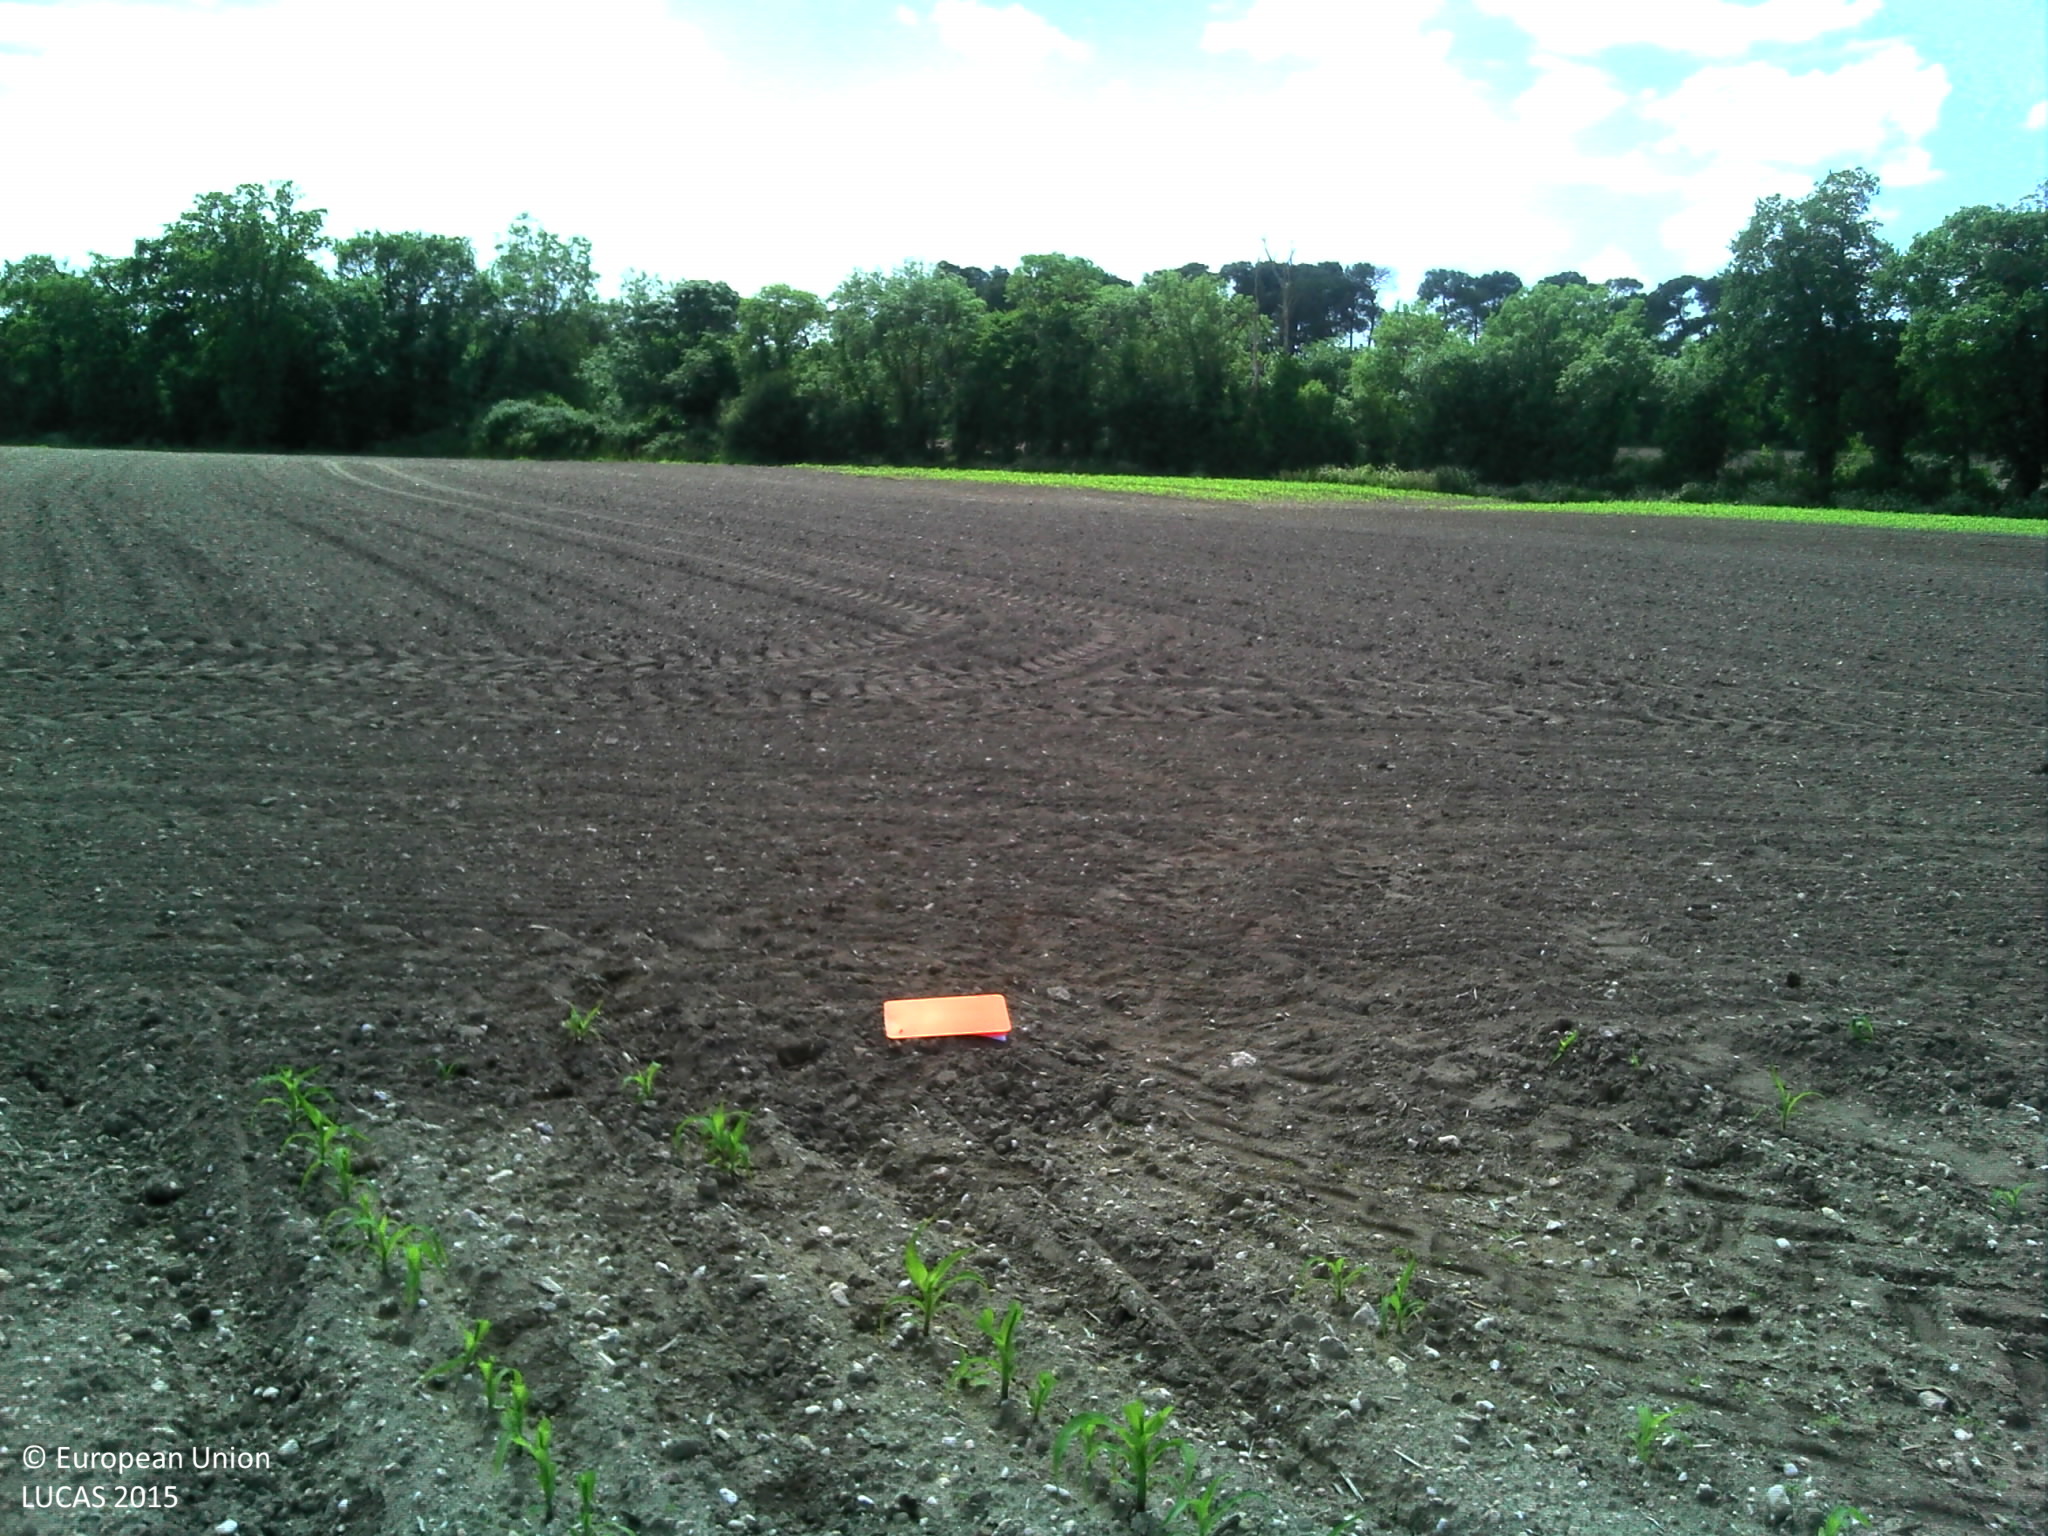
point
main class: Cropland
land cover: Maize
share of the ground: 10 - 25 %
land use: Agriculture (excluding fallow land and kitchen gardens)
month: June
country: FR
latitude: 46.8679
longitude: -1.8912
